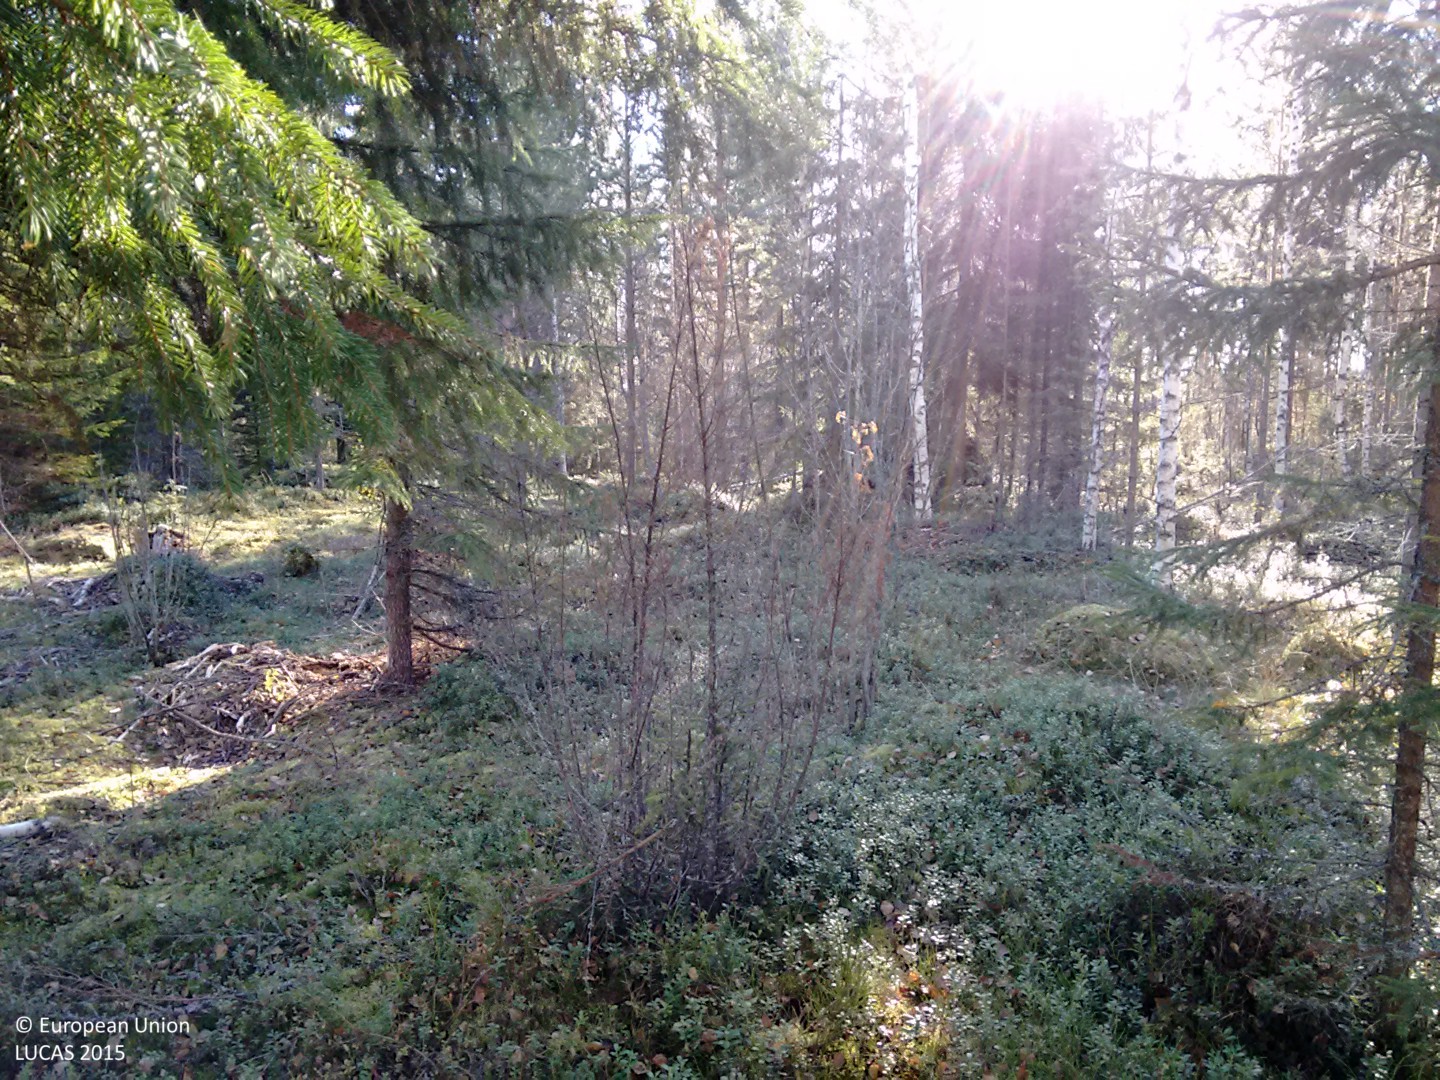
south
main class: Woodland
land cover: Other mixed woodland
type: boreal forest
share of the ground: > 75 %
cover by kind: broadleaved forest trees 45 %, coniferous forest trees 35 %, shrubs 20 %
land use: Forestry
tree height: > 5 m
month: October
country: FI
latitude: 62.4166
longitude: 26.1382
